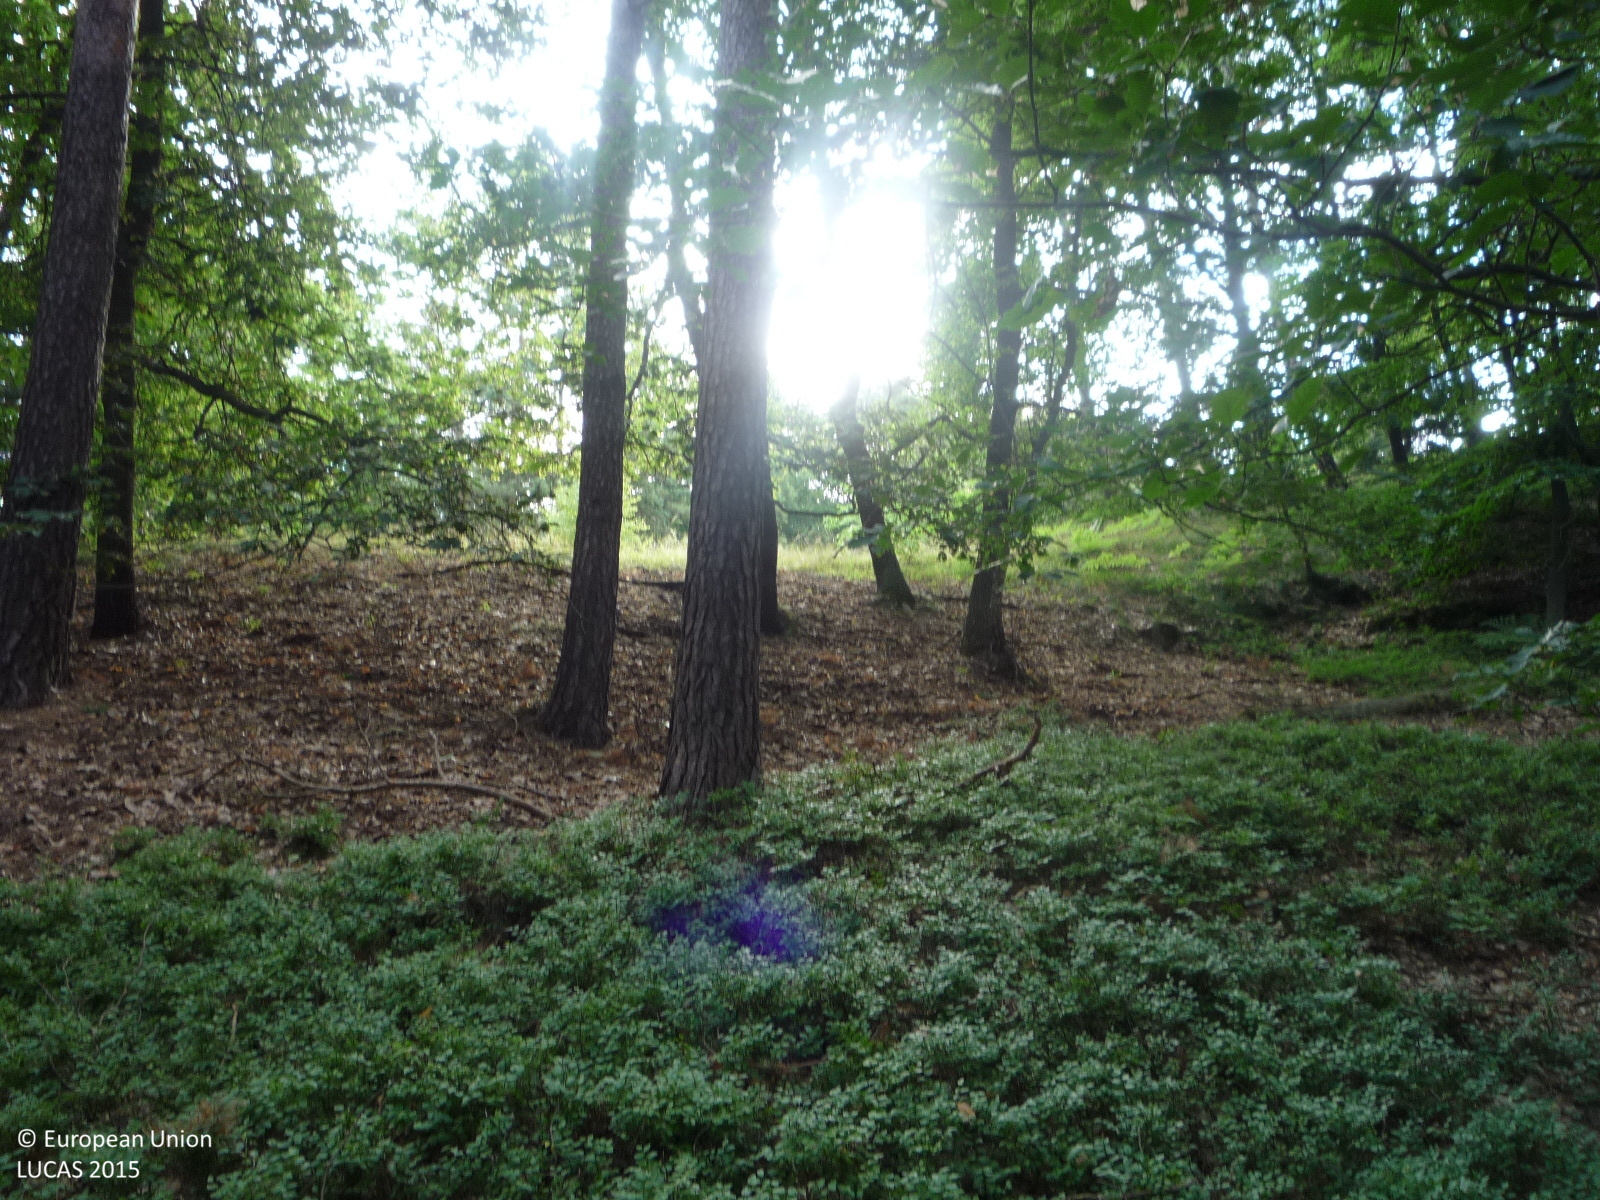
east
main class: Woodland
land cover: Pine dominated mixed woodland
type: hemiboreal forest and nemoral coniferous forest and mixed broadleaved-coniferous forest
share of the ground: > 75 %
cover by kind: coniferous forest trees 60 %, broadleaved forest trees 35 %, herbaceous plants 5 %
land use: Forestry
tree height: > 5 m
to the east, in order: Pine dominated mixed woodland; Grassland with sparse tree/shrub cover; Rock outcrops; Pine dominated mixed woodland; Rock outcrops; Pine dominated mixed woodland; Grassland with sparse tree/shrub cover; Tracks; Grassland without tree/shrub cover
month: July
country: CZ
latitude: 50.5086
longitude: 14.5282
